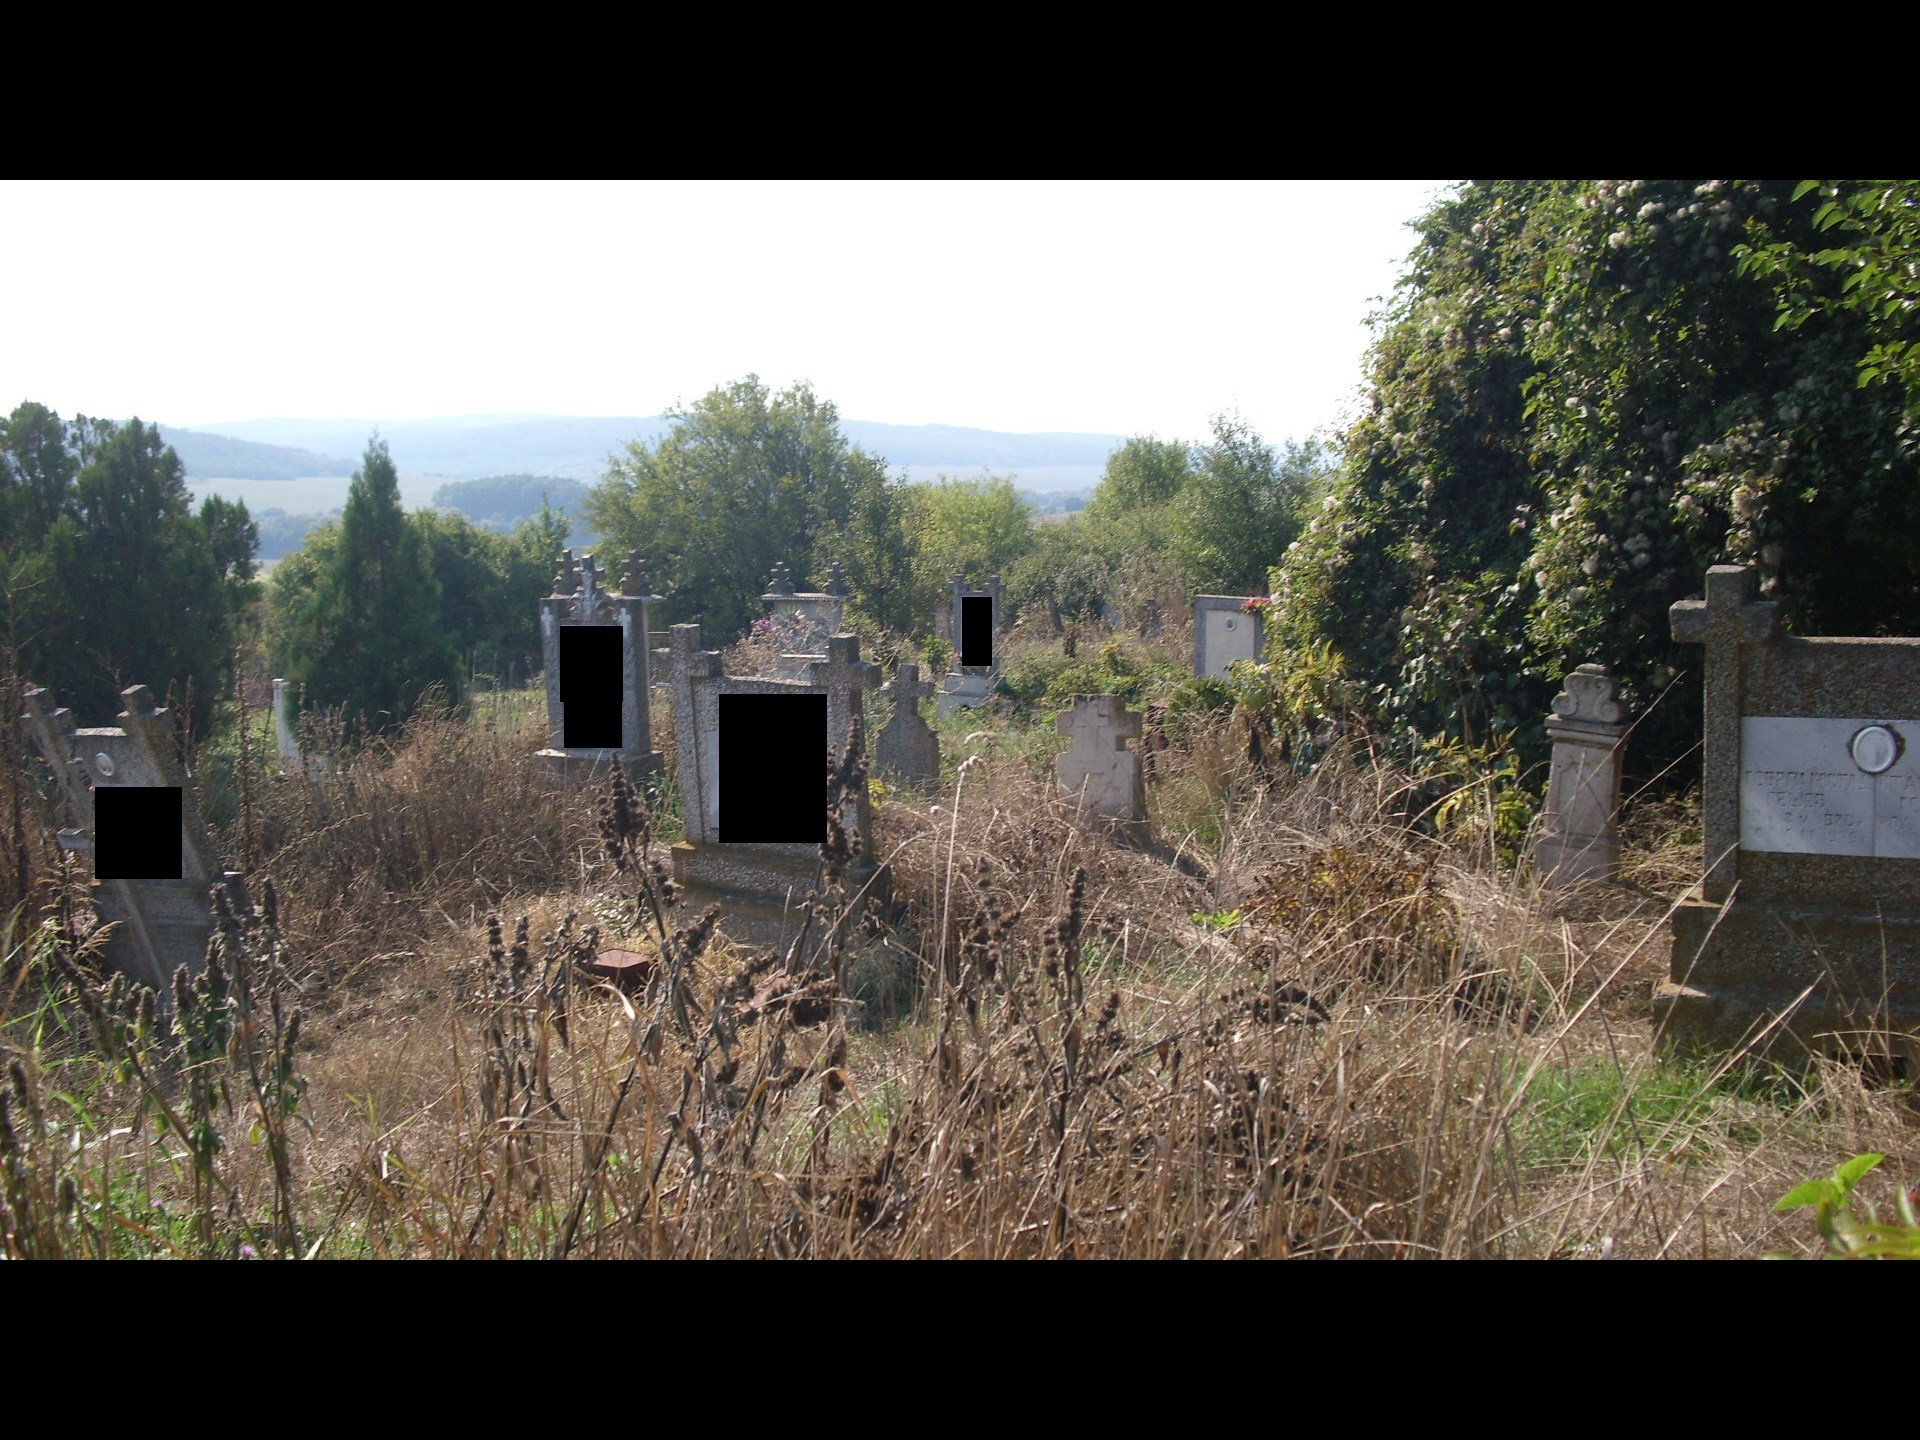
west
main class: Shrubland
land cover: Shrubland with sparse tree cover
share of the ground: > 75 %
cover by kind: shrubs 80 %, herbaceous plants 15 %, broadleaved forest trees 5 %
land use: Community services
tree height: < 5 m
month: August
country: BG
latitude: 44.0698
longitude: 22.7614
